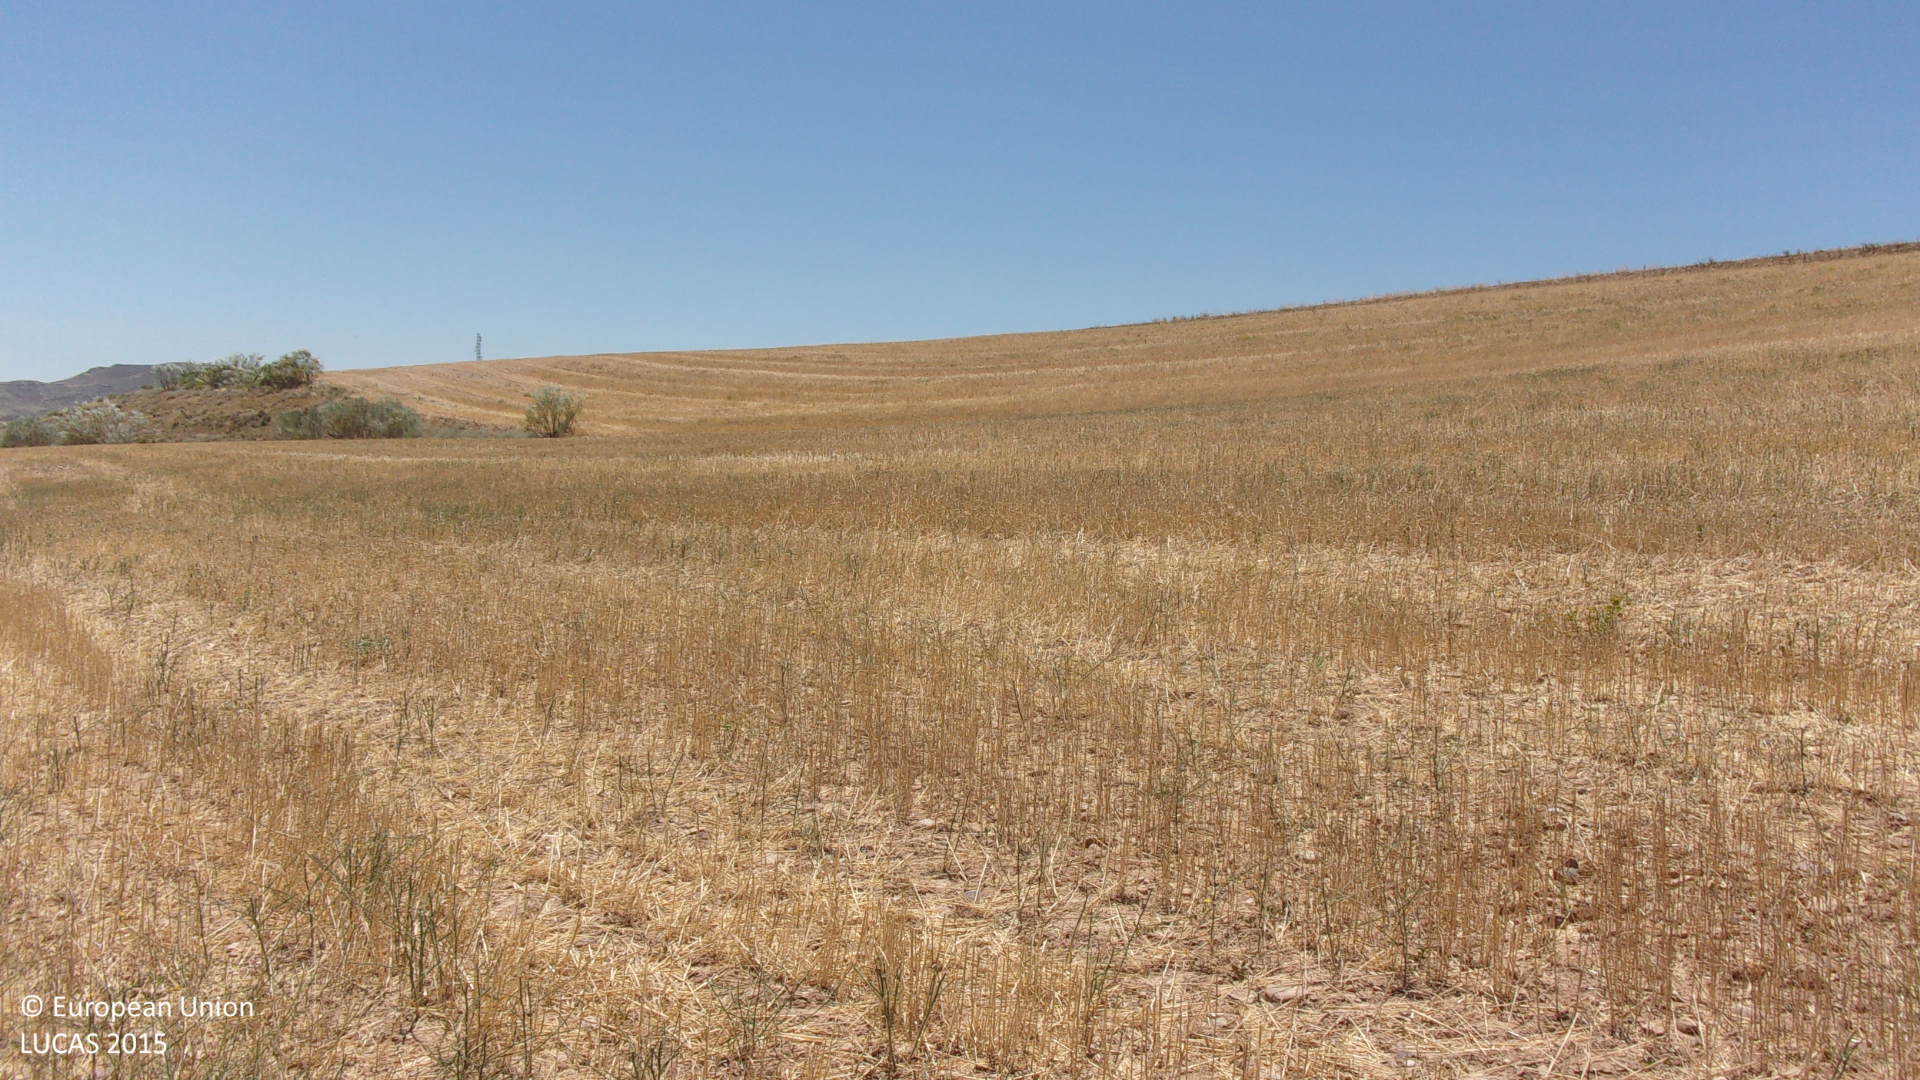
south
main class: Cropland
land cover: Durum wheat
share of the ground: < 10 %
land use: Agriculture (excluding fallow land and kitchen gardens)
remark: Harvested field
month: July
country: ES
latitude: 41.6783
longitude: -1.2567
